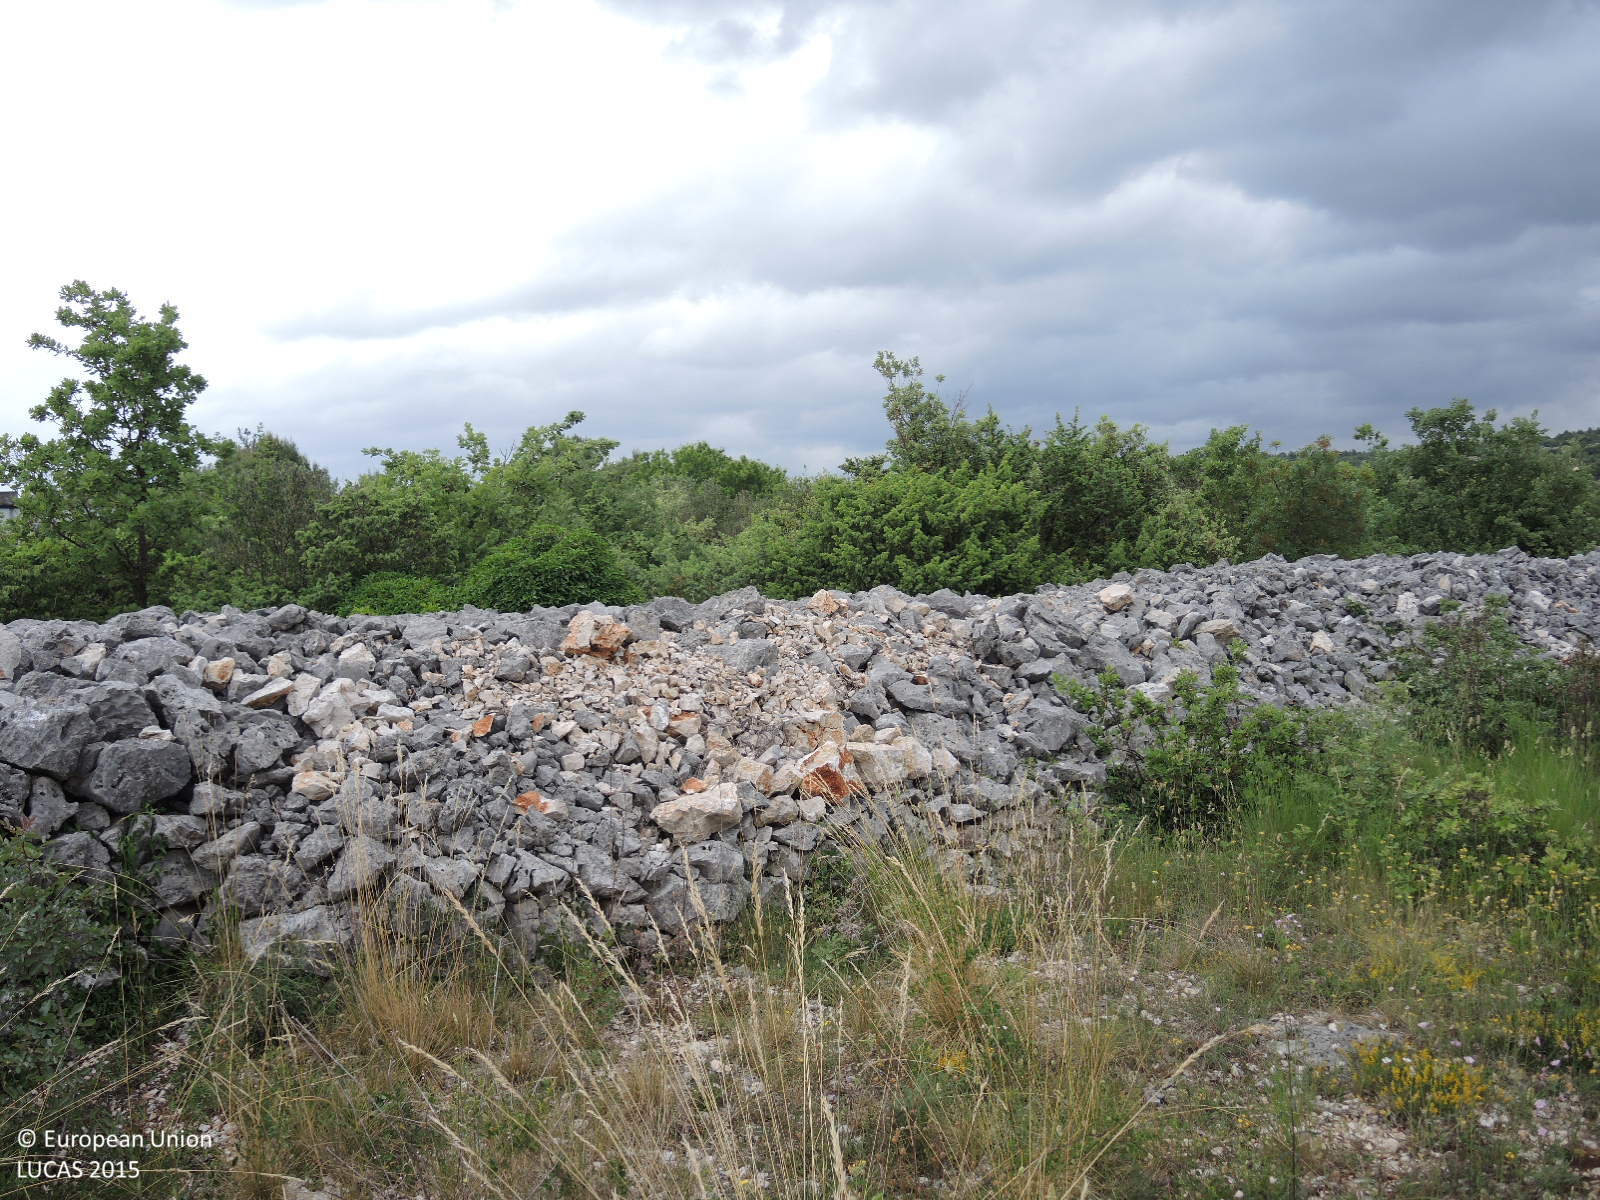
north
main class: Cropland
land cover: Olive groves
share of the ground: 10 - 25 %
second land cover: Spontaneously vegetated surfaces
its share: > 75 %
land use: Agriculture (excluding fallow land and kitchen gardens)
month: May
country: HR
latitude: 43.8088
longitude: 15.7965
